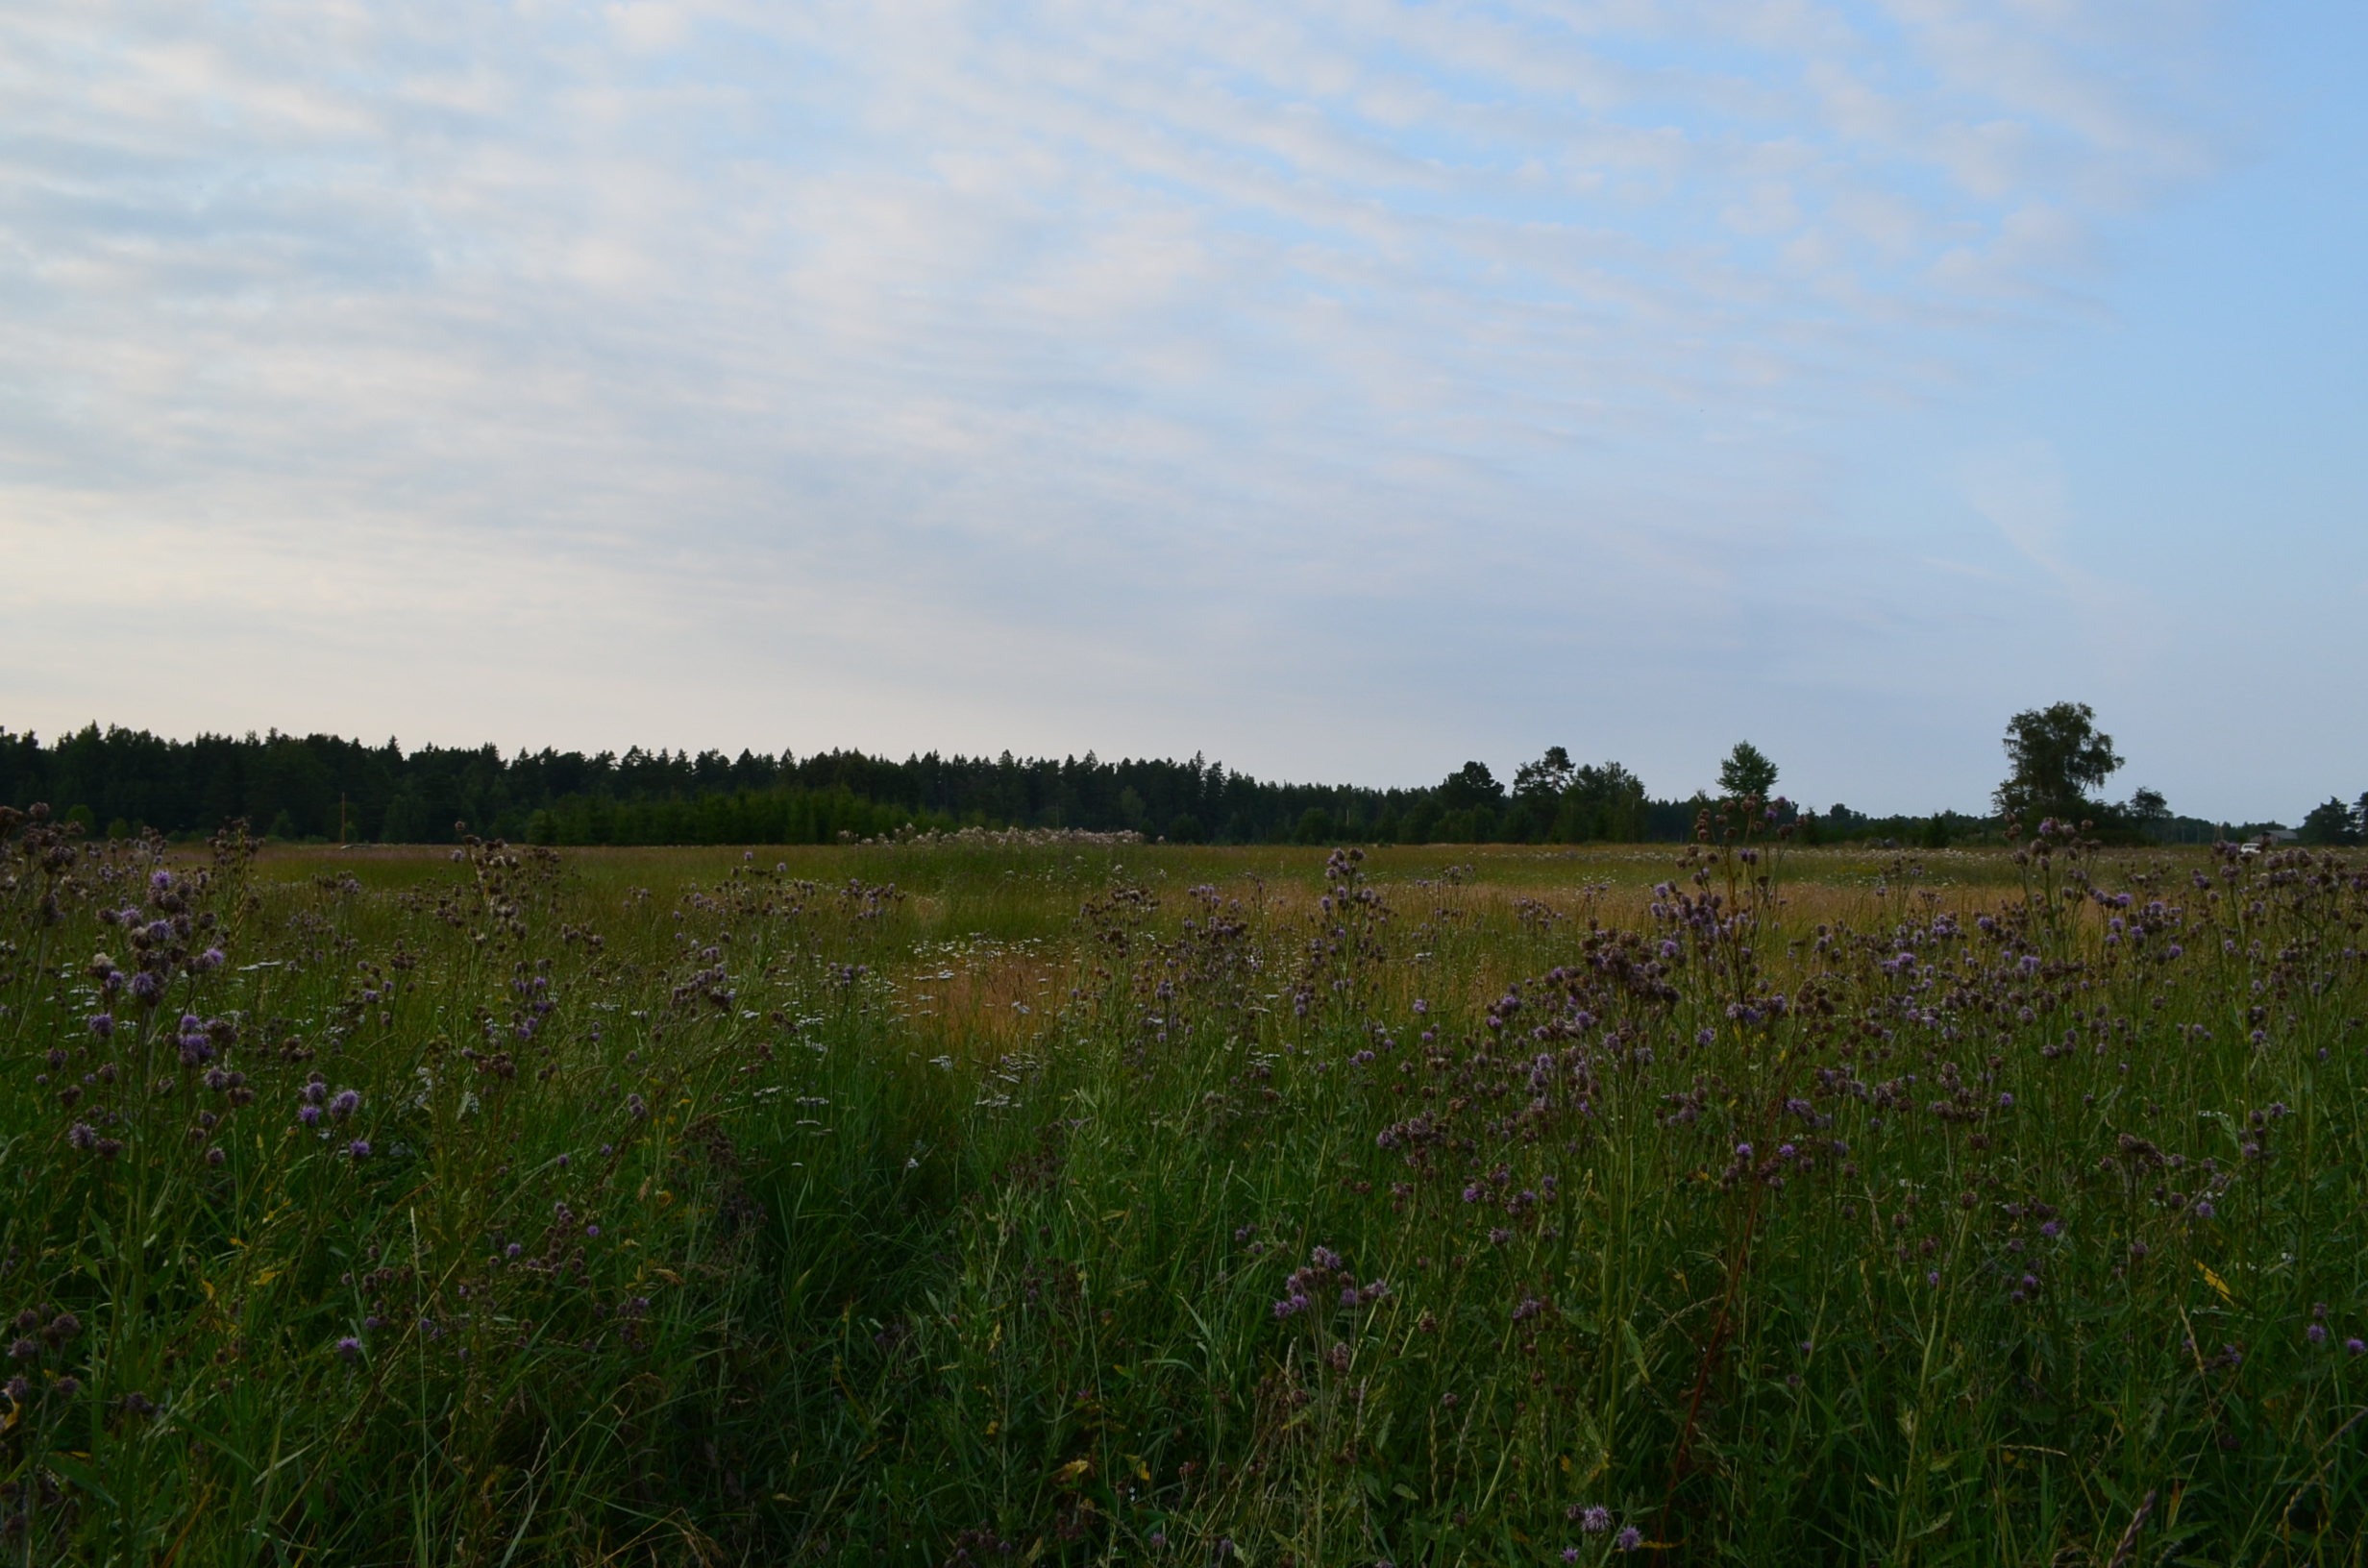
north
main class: Grassland
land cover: Spontaneously vegetated surfaces
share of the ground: > 75 %
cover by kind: herbaceous plants 100 %
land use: Semi-natural and natural areas not in use
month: August
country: LV
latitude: 57.2343
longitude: 21.8900
